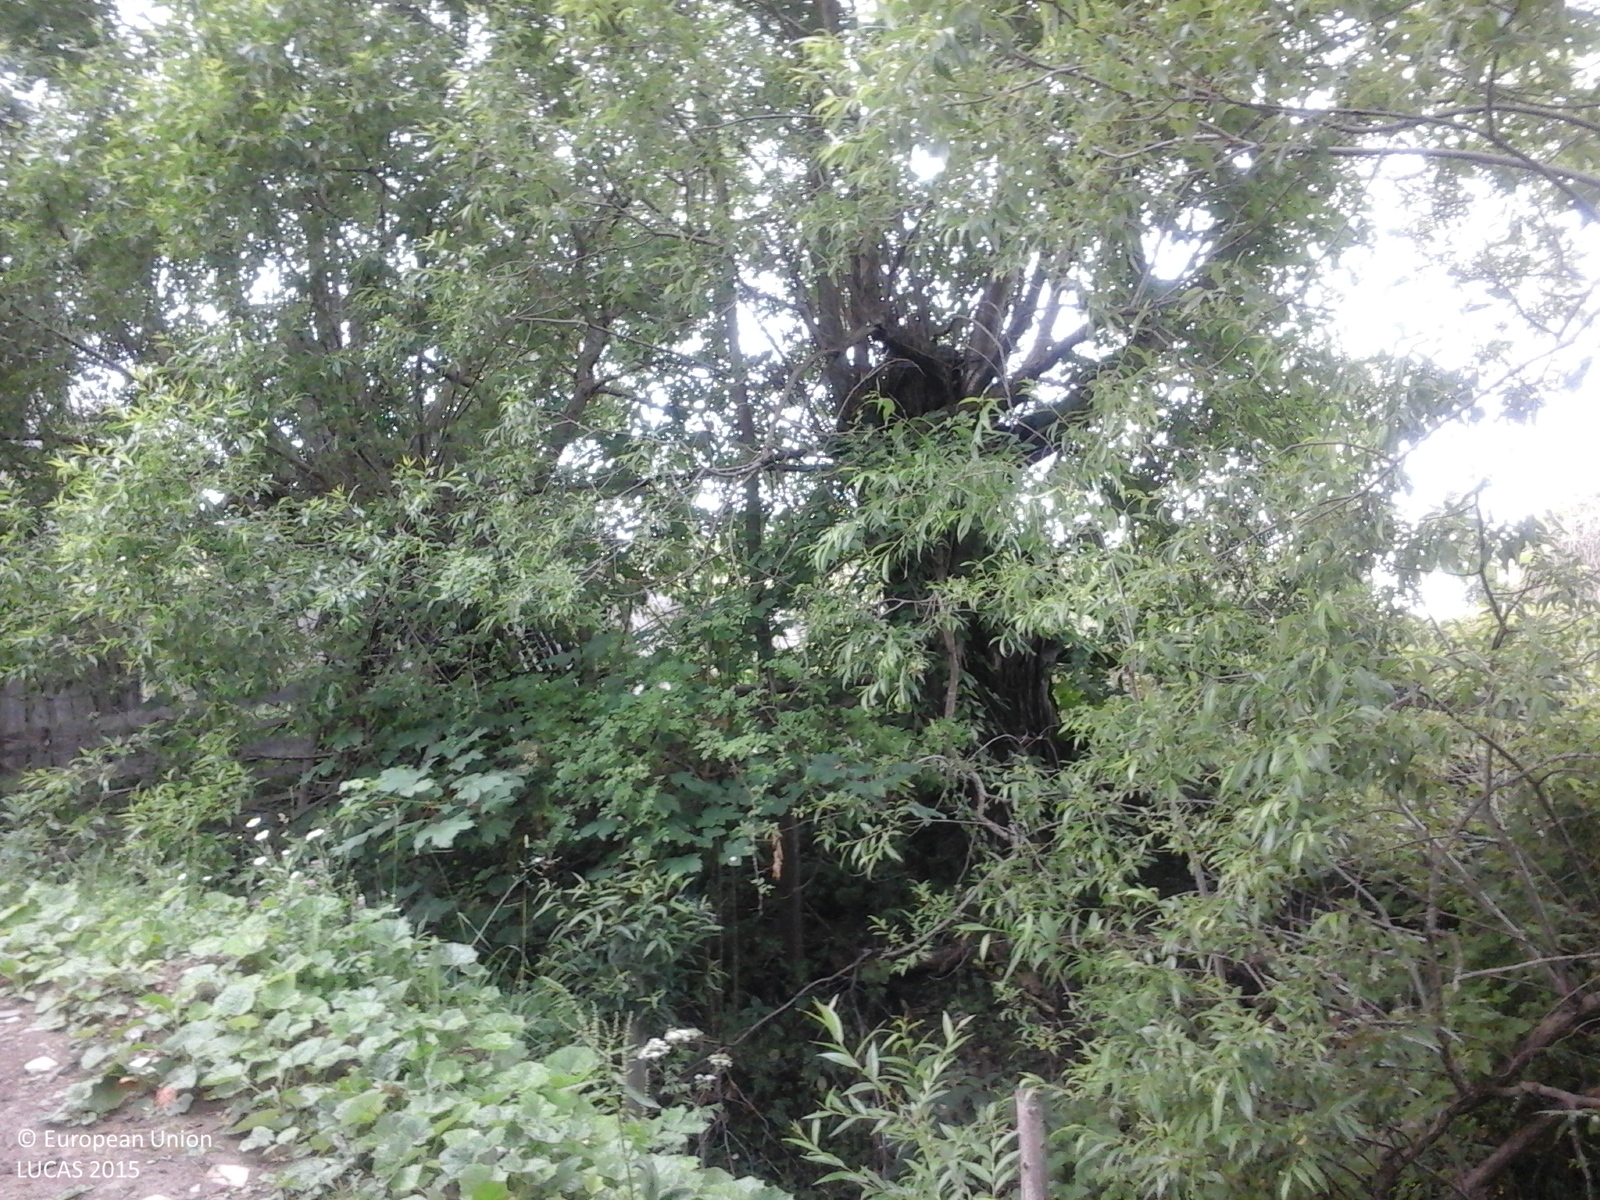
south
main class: Grassland
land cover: Grassland without tree/shrub cover
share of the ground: > 75 %
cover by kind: herbaceous plants 100 %
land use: Agriculture (excluding fallow land and kitchen gardens)
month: June
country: RO
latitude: 47.4963
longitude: 25.8004
